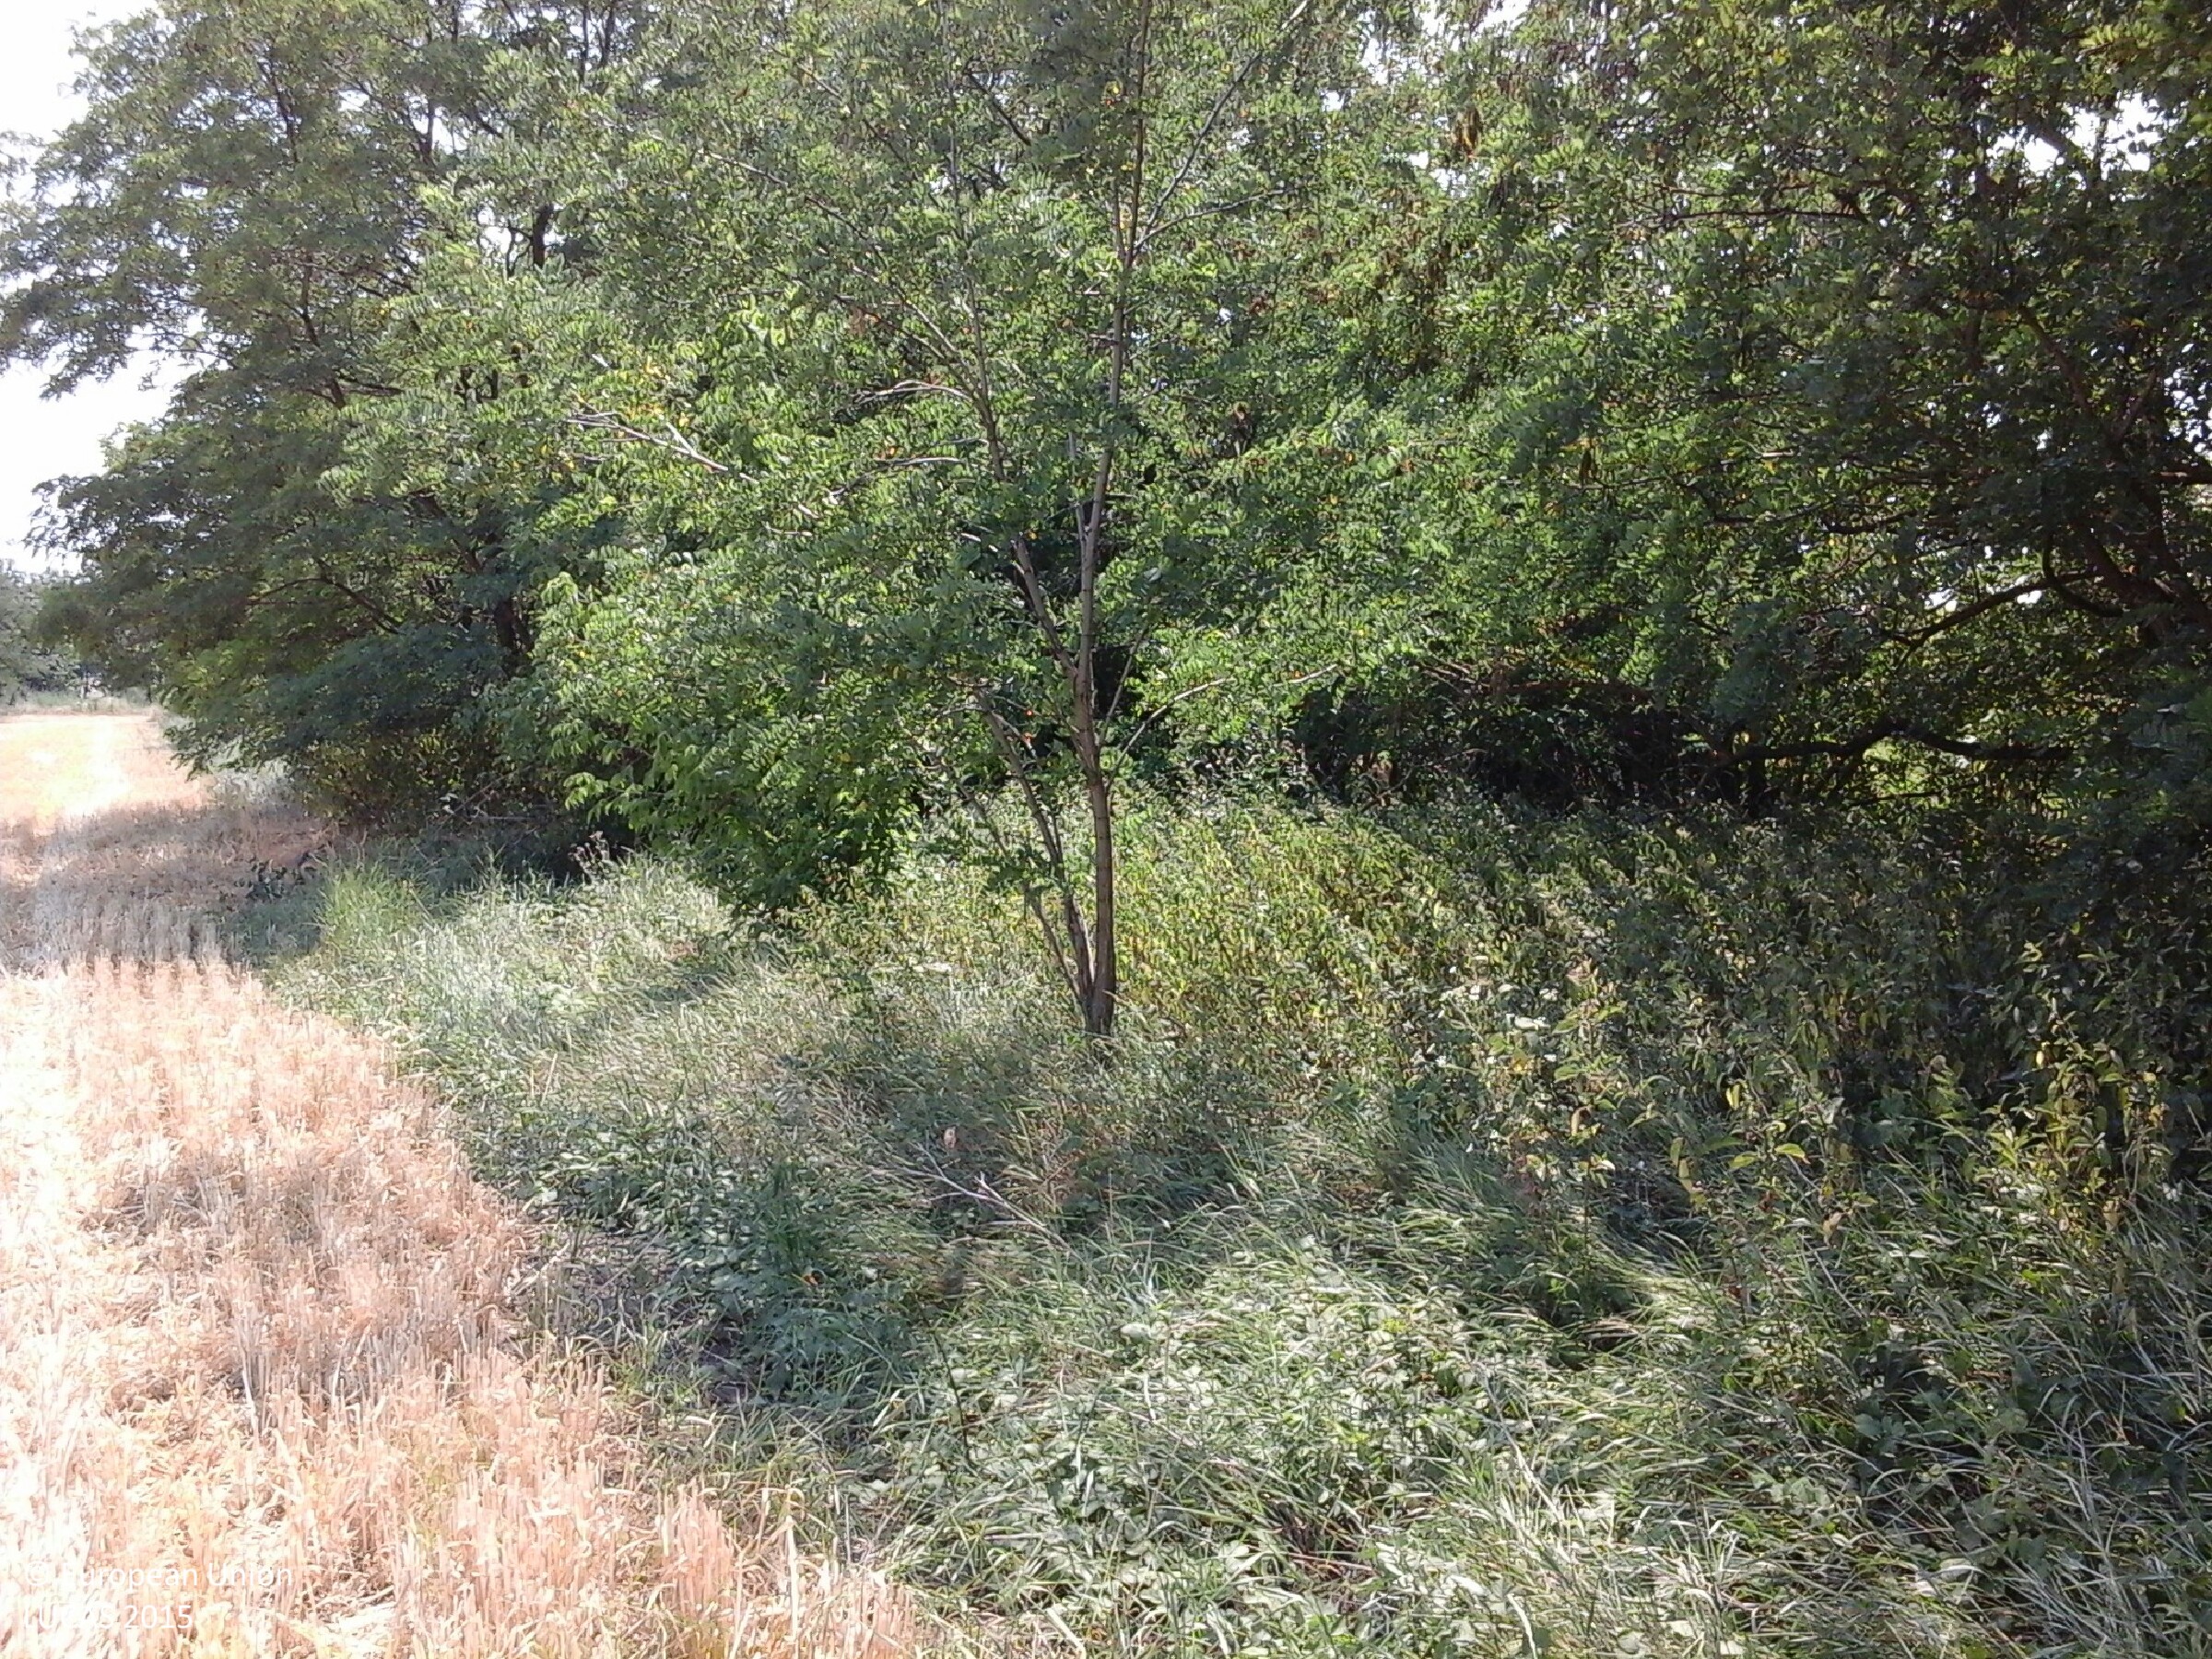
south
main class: Cropland
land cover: Common wheat
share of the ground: > 75 %
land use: Agriculture (excluding fallow land and kitchen gardens)
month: July
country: HU
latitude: 48.0828
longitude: 21.0610
